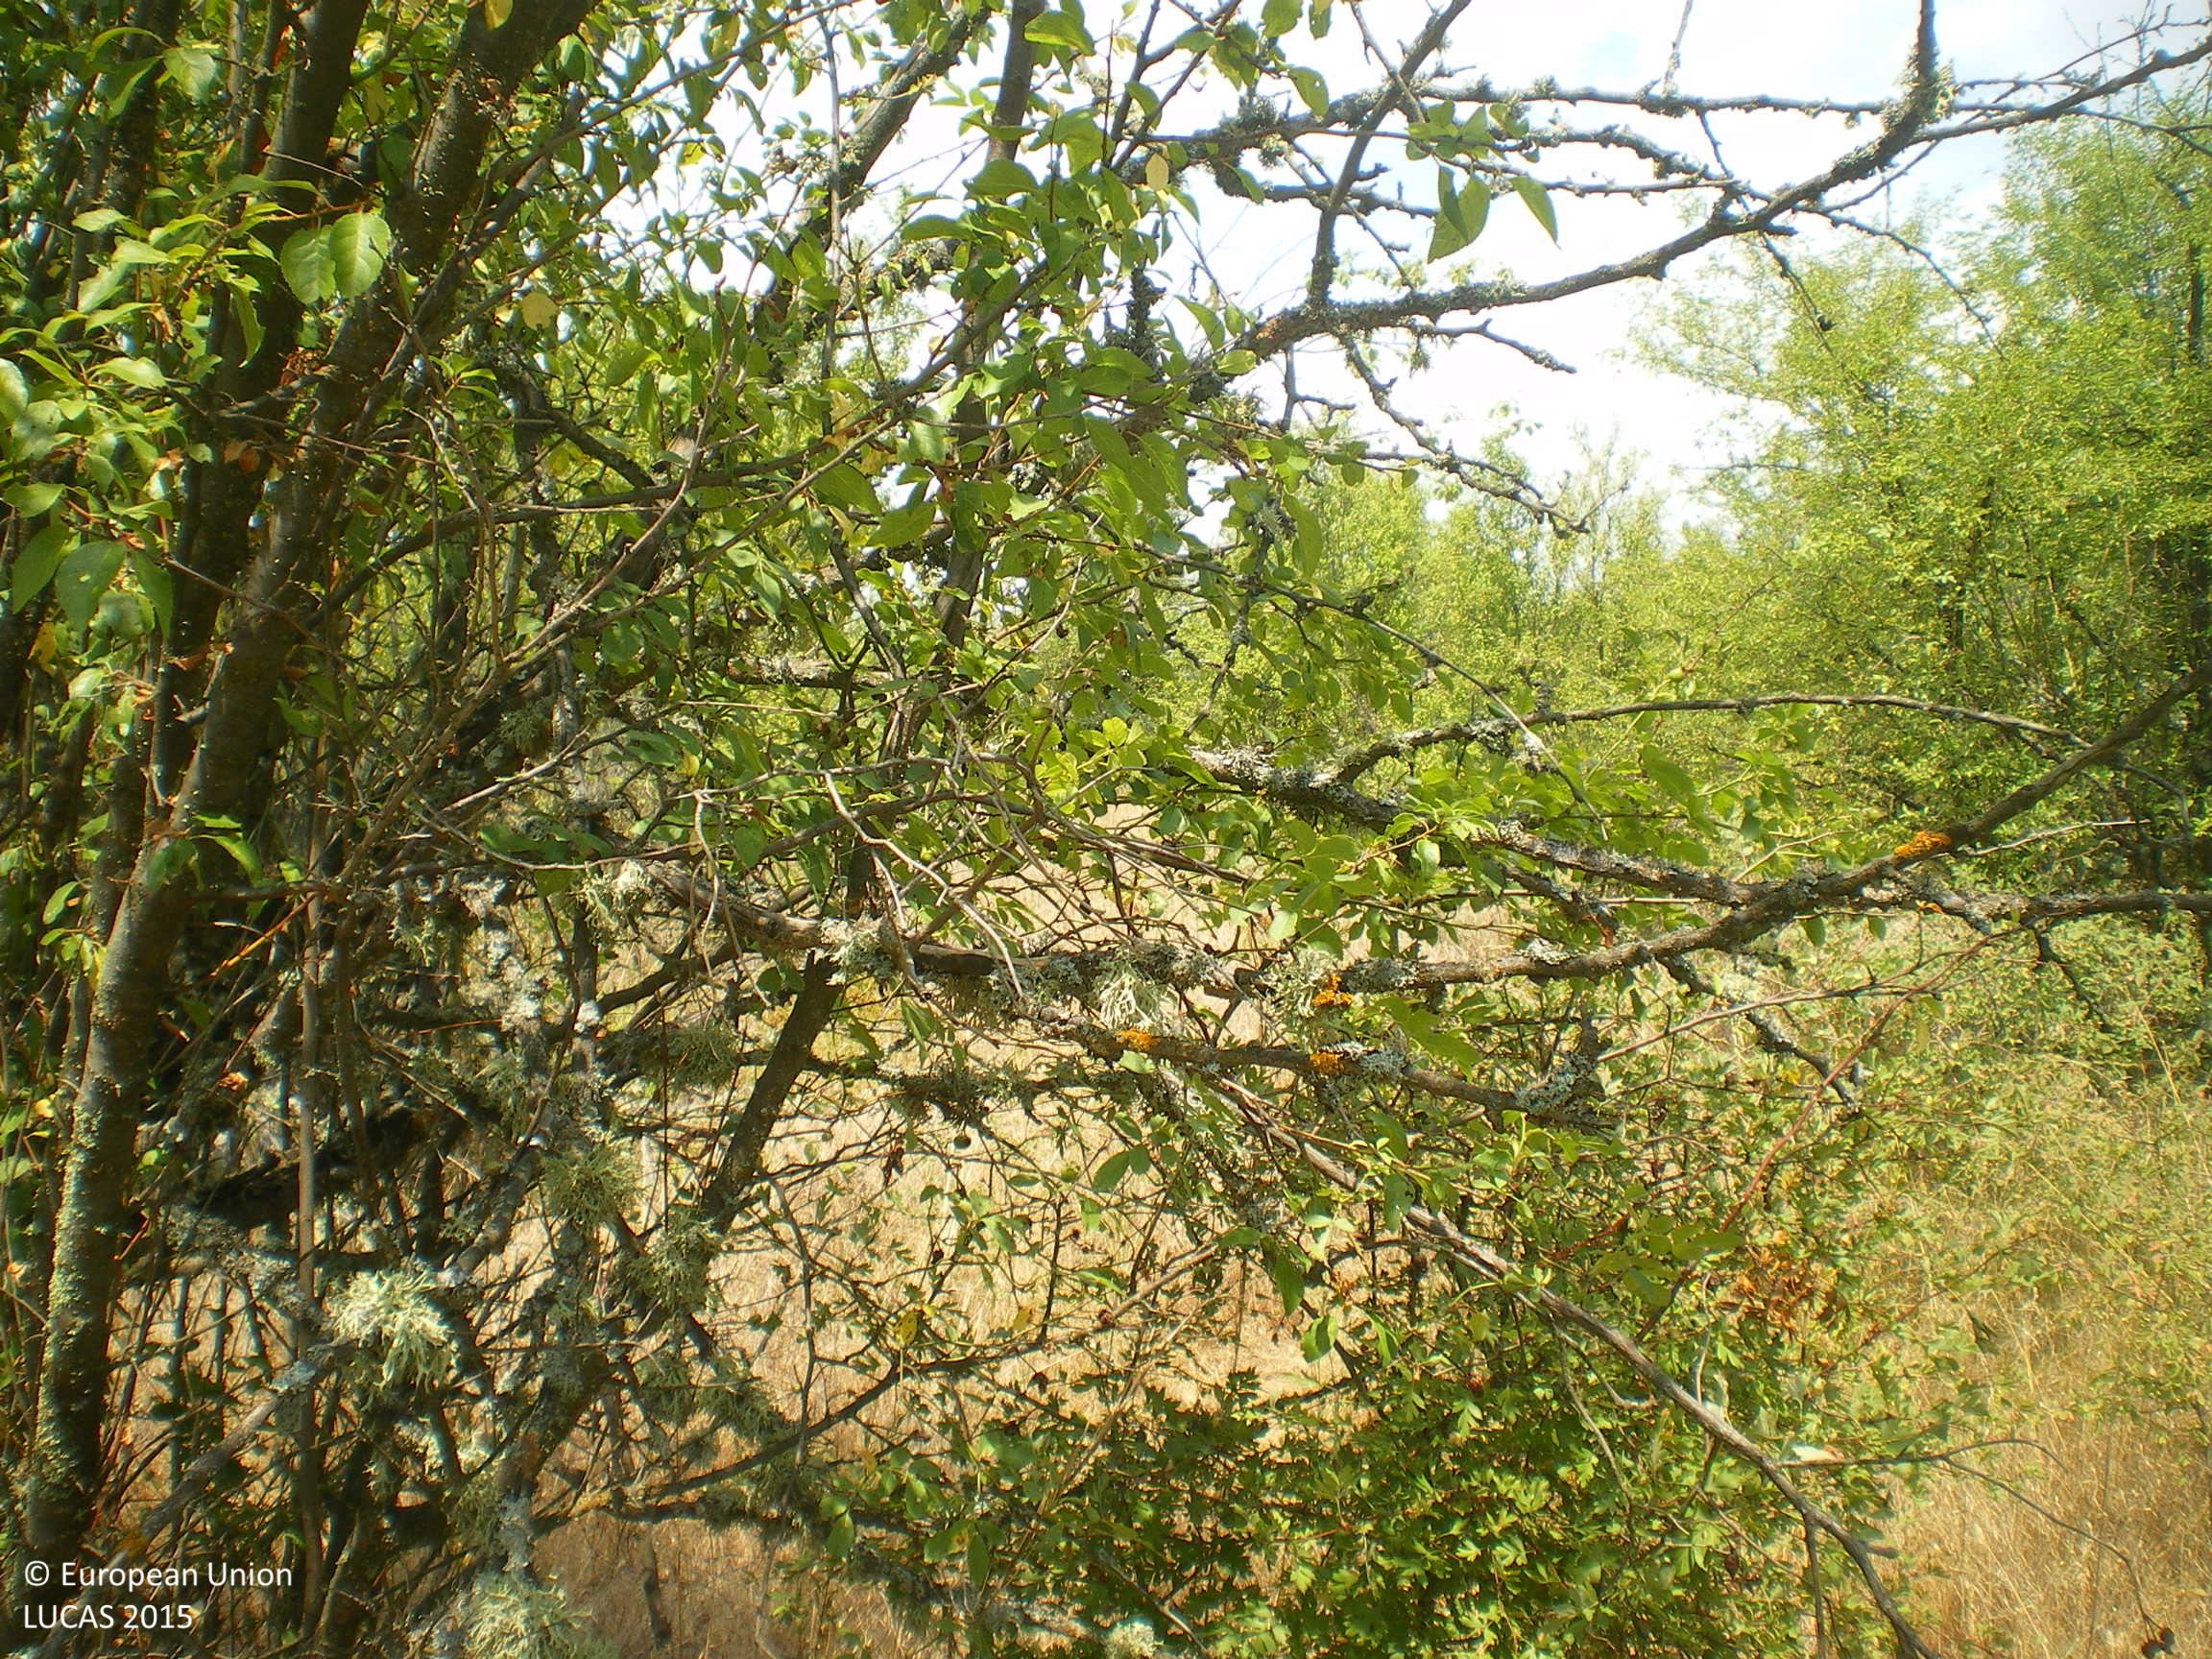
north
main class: Cropland
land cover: Other fruit trees and berries
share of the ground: 50 - 75 %
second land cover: Grassland without tree/shrub cover
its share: 25 - 50 %
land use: Abandoned areas
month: August
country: BG
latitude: 42.3845
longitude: 25.4075
